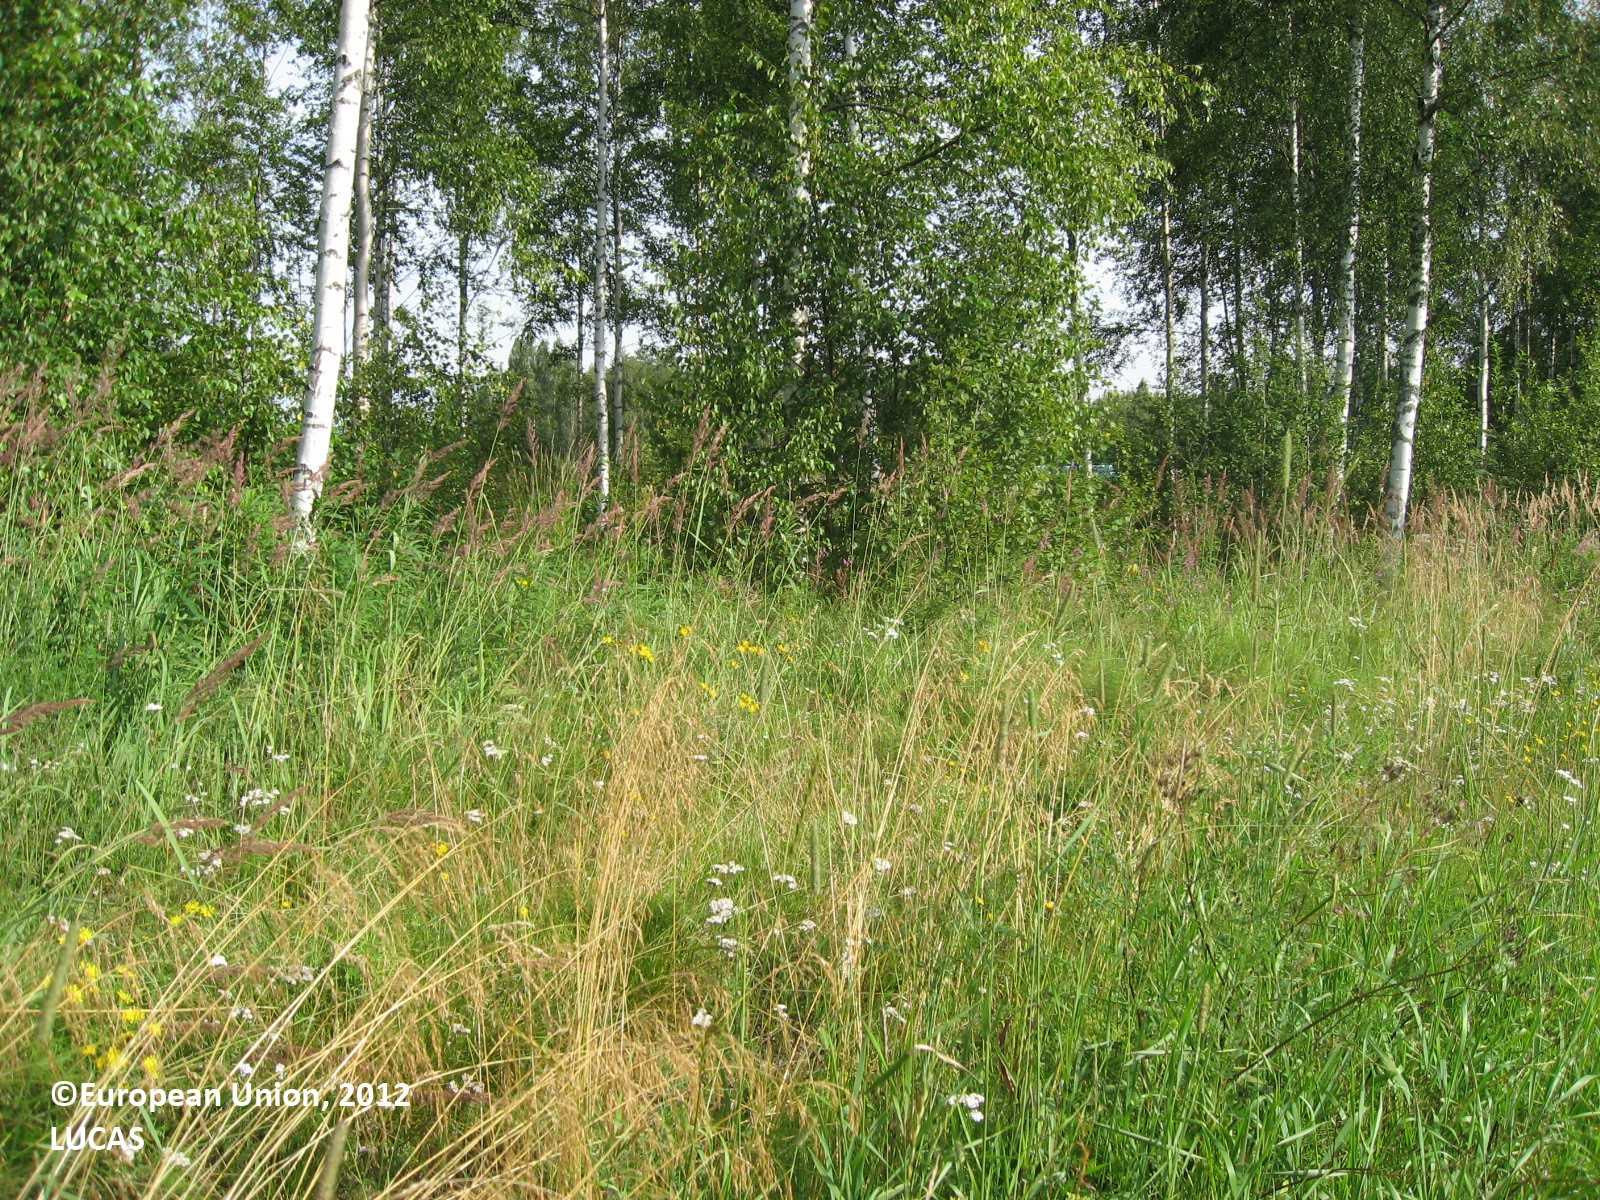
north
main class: Cropland
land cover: Oats
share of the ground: > 75 %
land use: Agriculture (excluding fallow land and kitchen gardens)
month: August
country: FI
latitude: 61.5147
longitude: 25.9392
